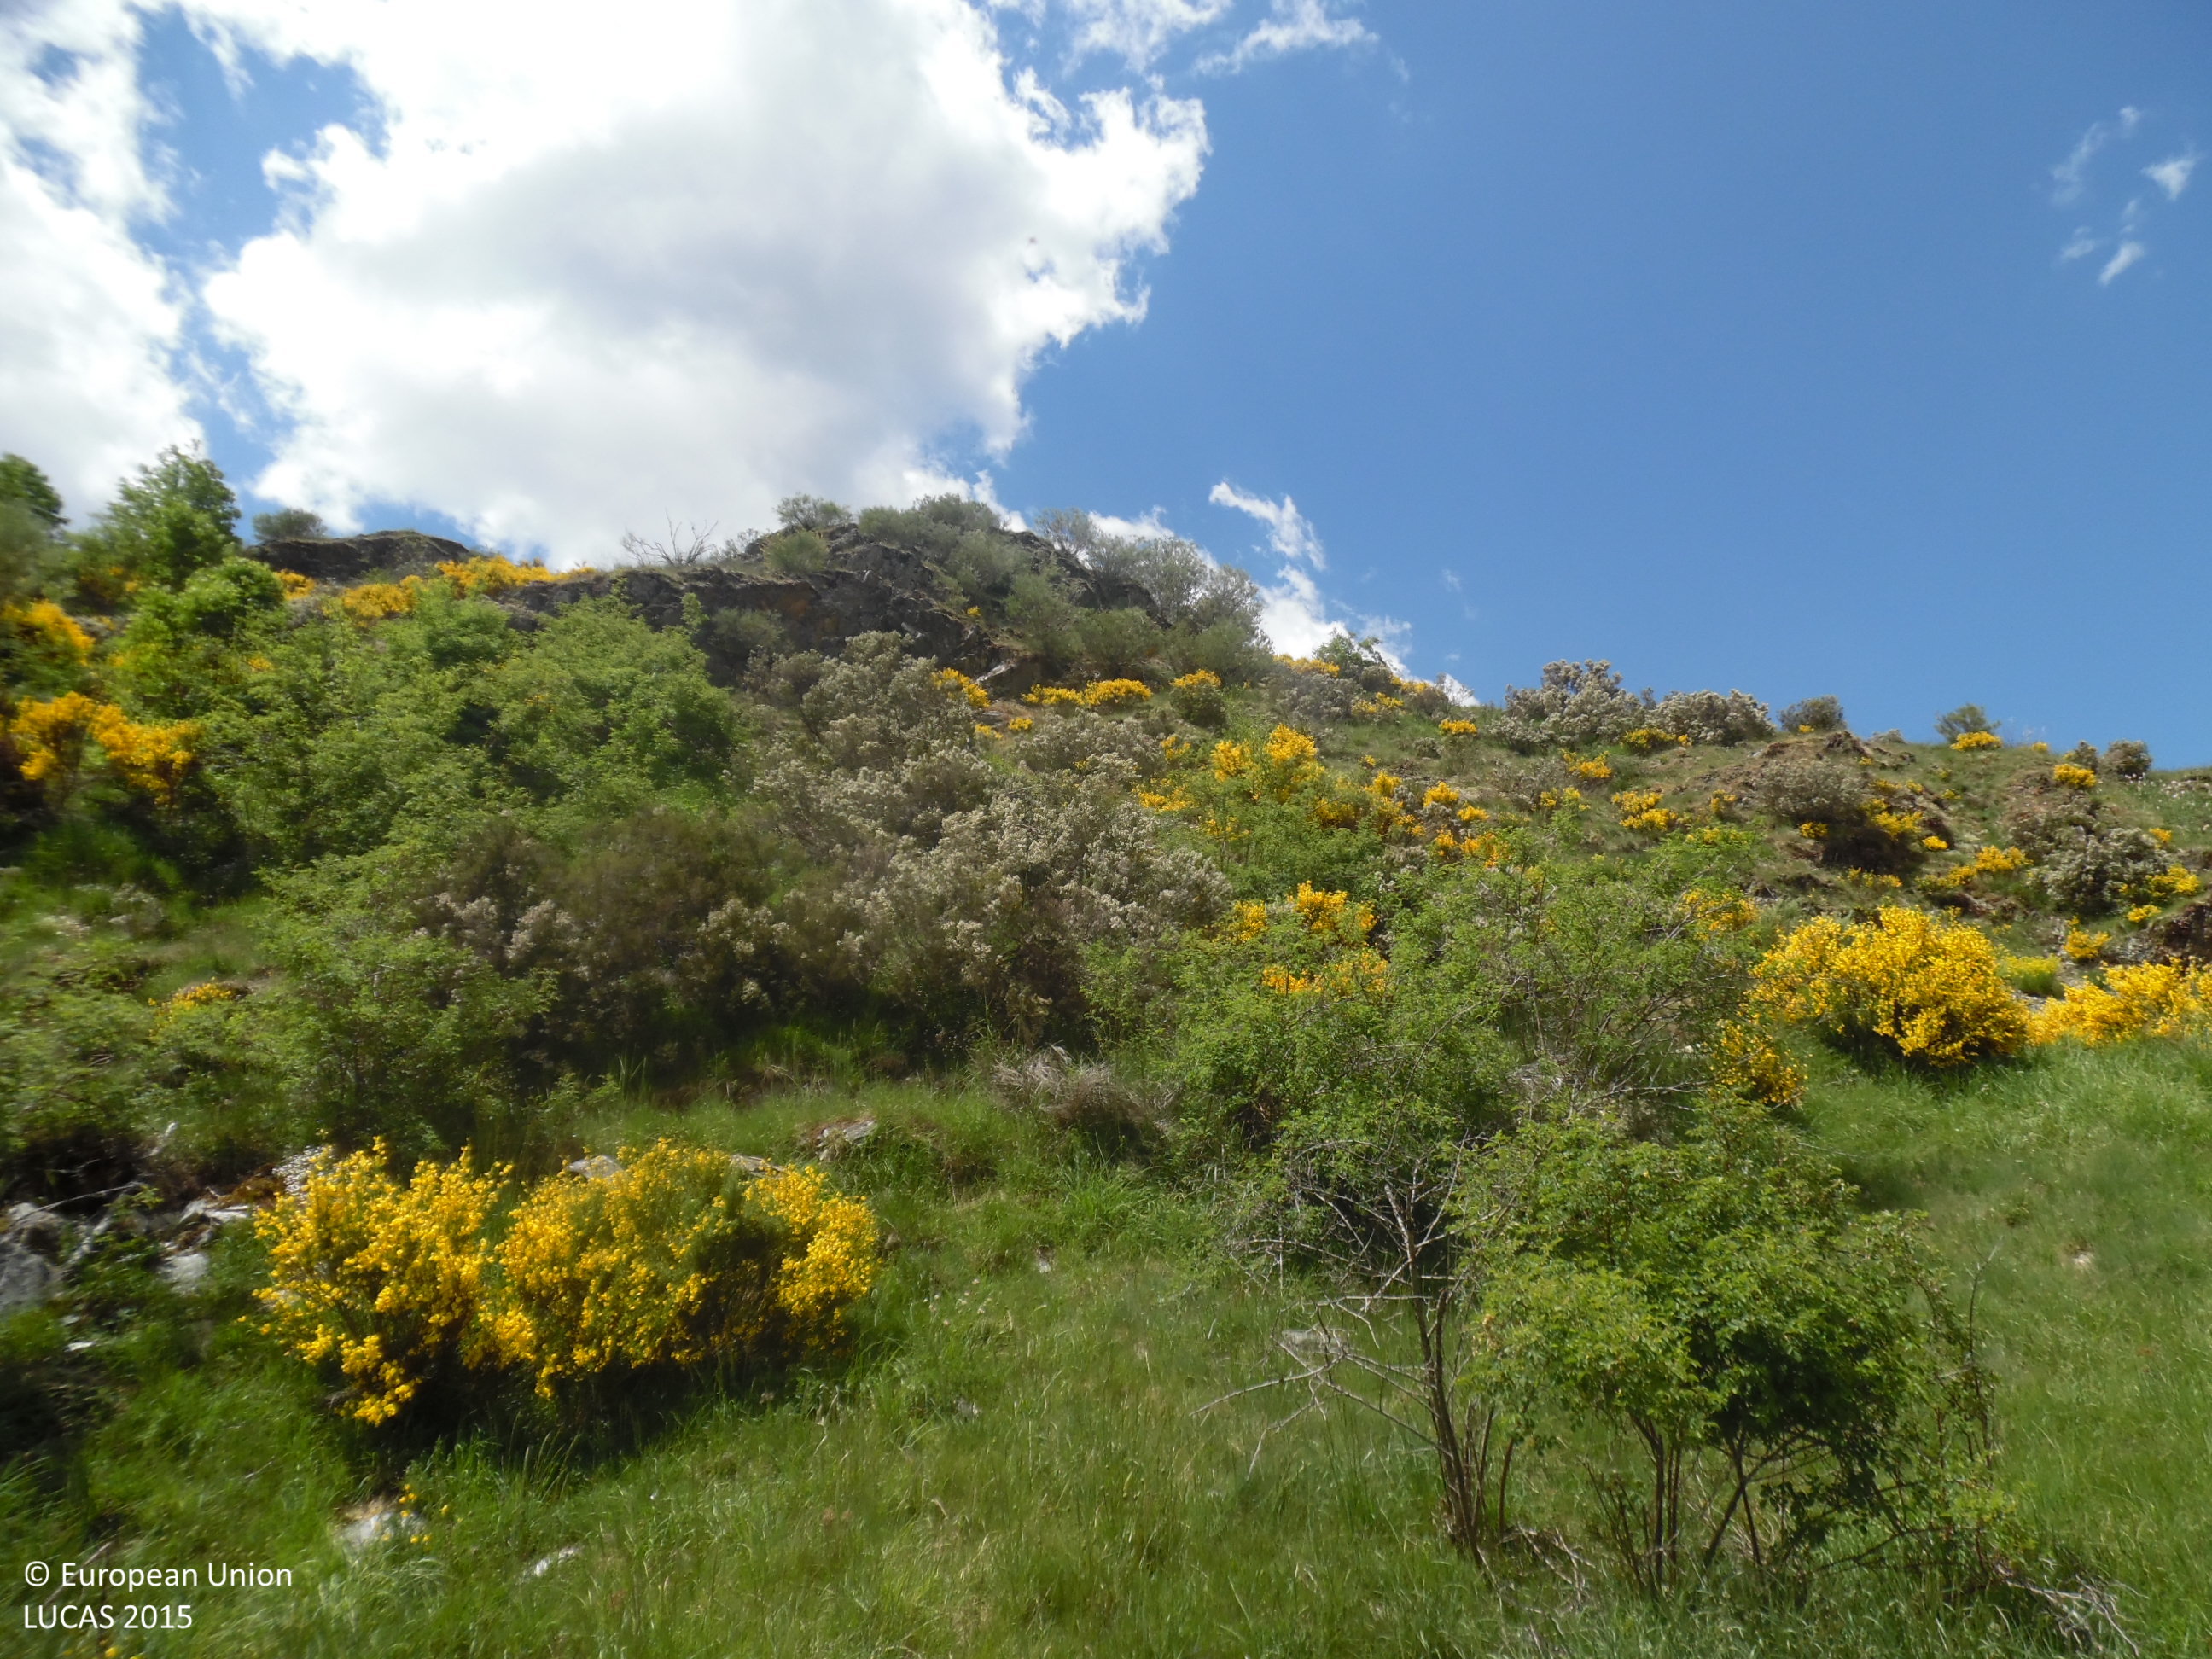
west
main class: Shrubland
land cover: Shrubland with sparse tree cover
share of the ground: > 75 %
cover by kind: shrubs 90 %, broadleaved forest trees 5 %, herbaceous plants 5 %
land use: Agriculture (excluding fallow land and kitchen gardens)
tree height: < 5 m
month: May
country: ES
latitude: 42.8950
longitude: -6.2436
